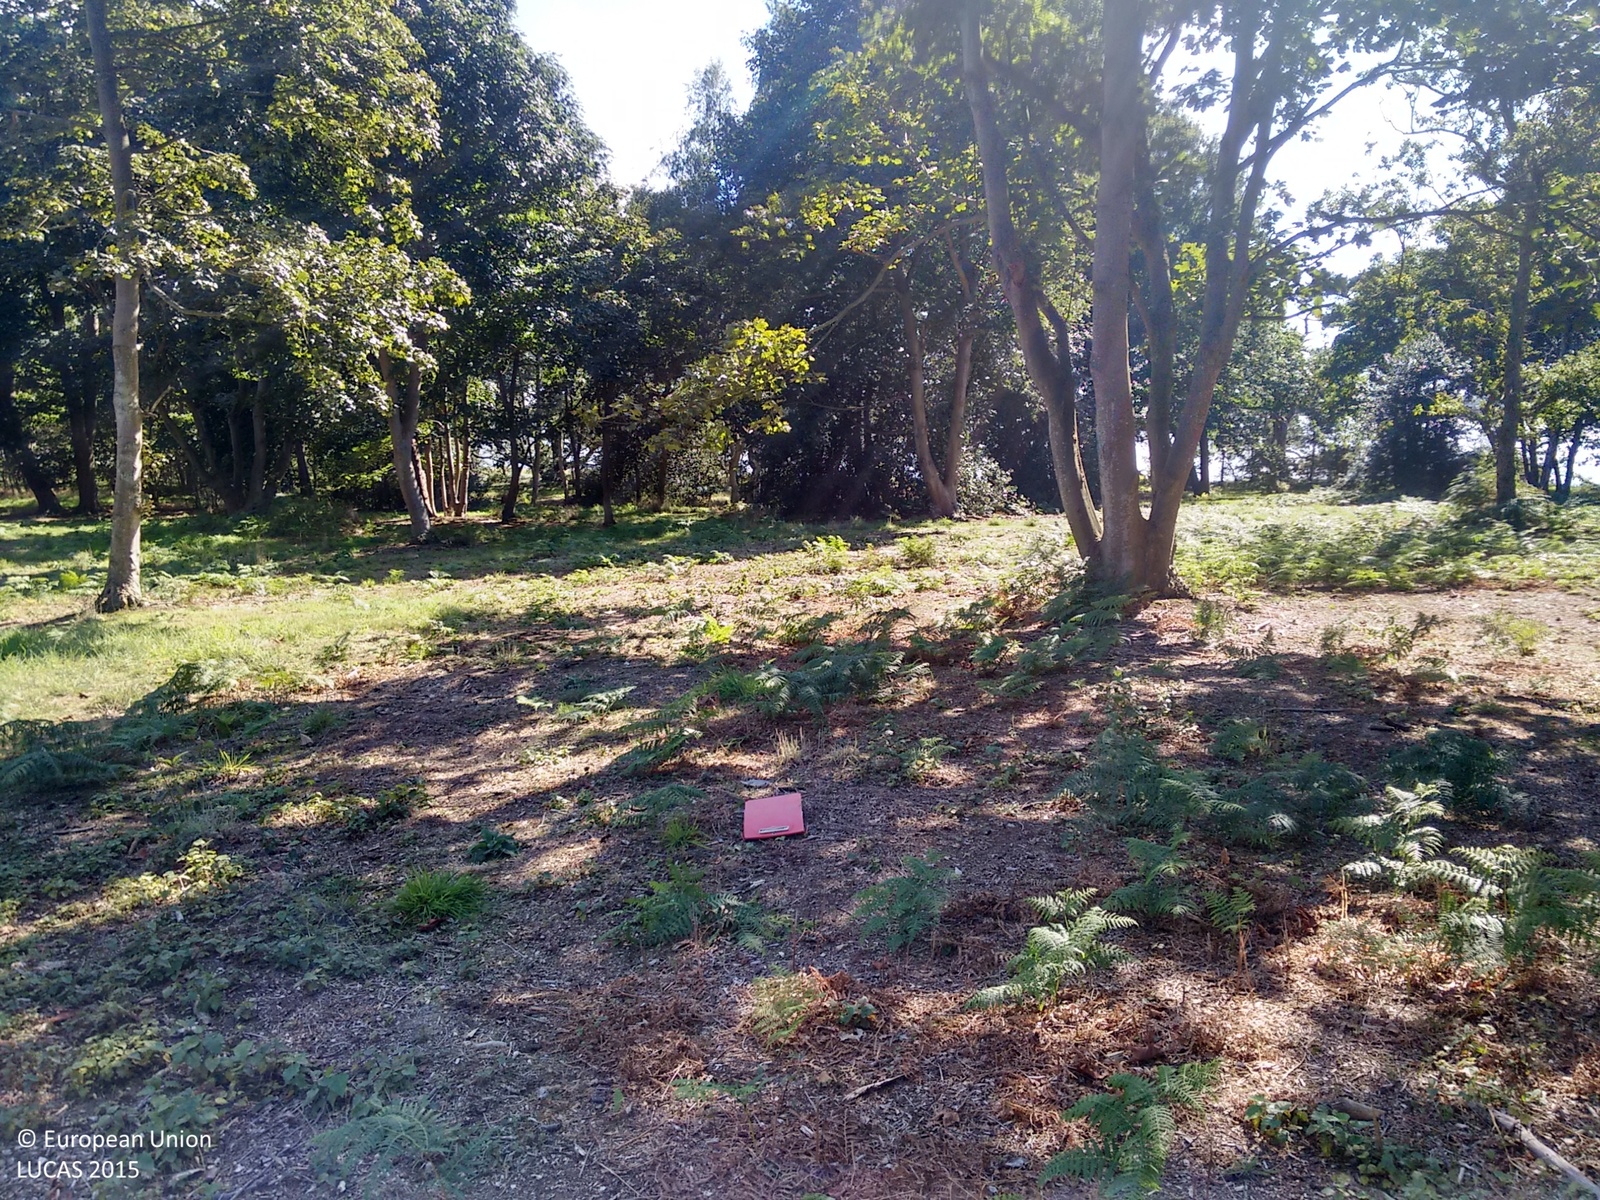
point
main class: Woodland
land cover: Broadleaved woodland
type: mesophytic deciduous forest
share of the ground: 25 - 50 %
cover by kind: herbaceous plants 70 %, broadleaved forest trees 30 %
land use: Forestry
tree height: > 5 m
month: September
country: GB
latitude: 52.1659
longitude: 1.5454
